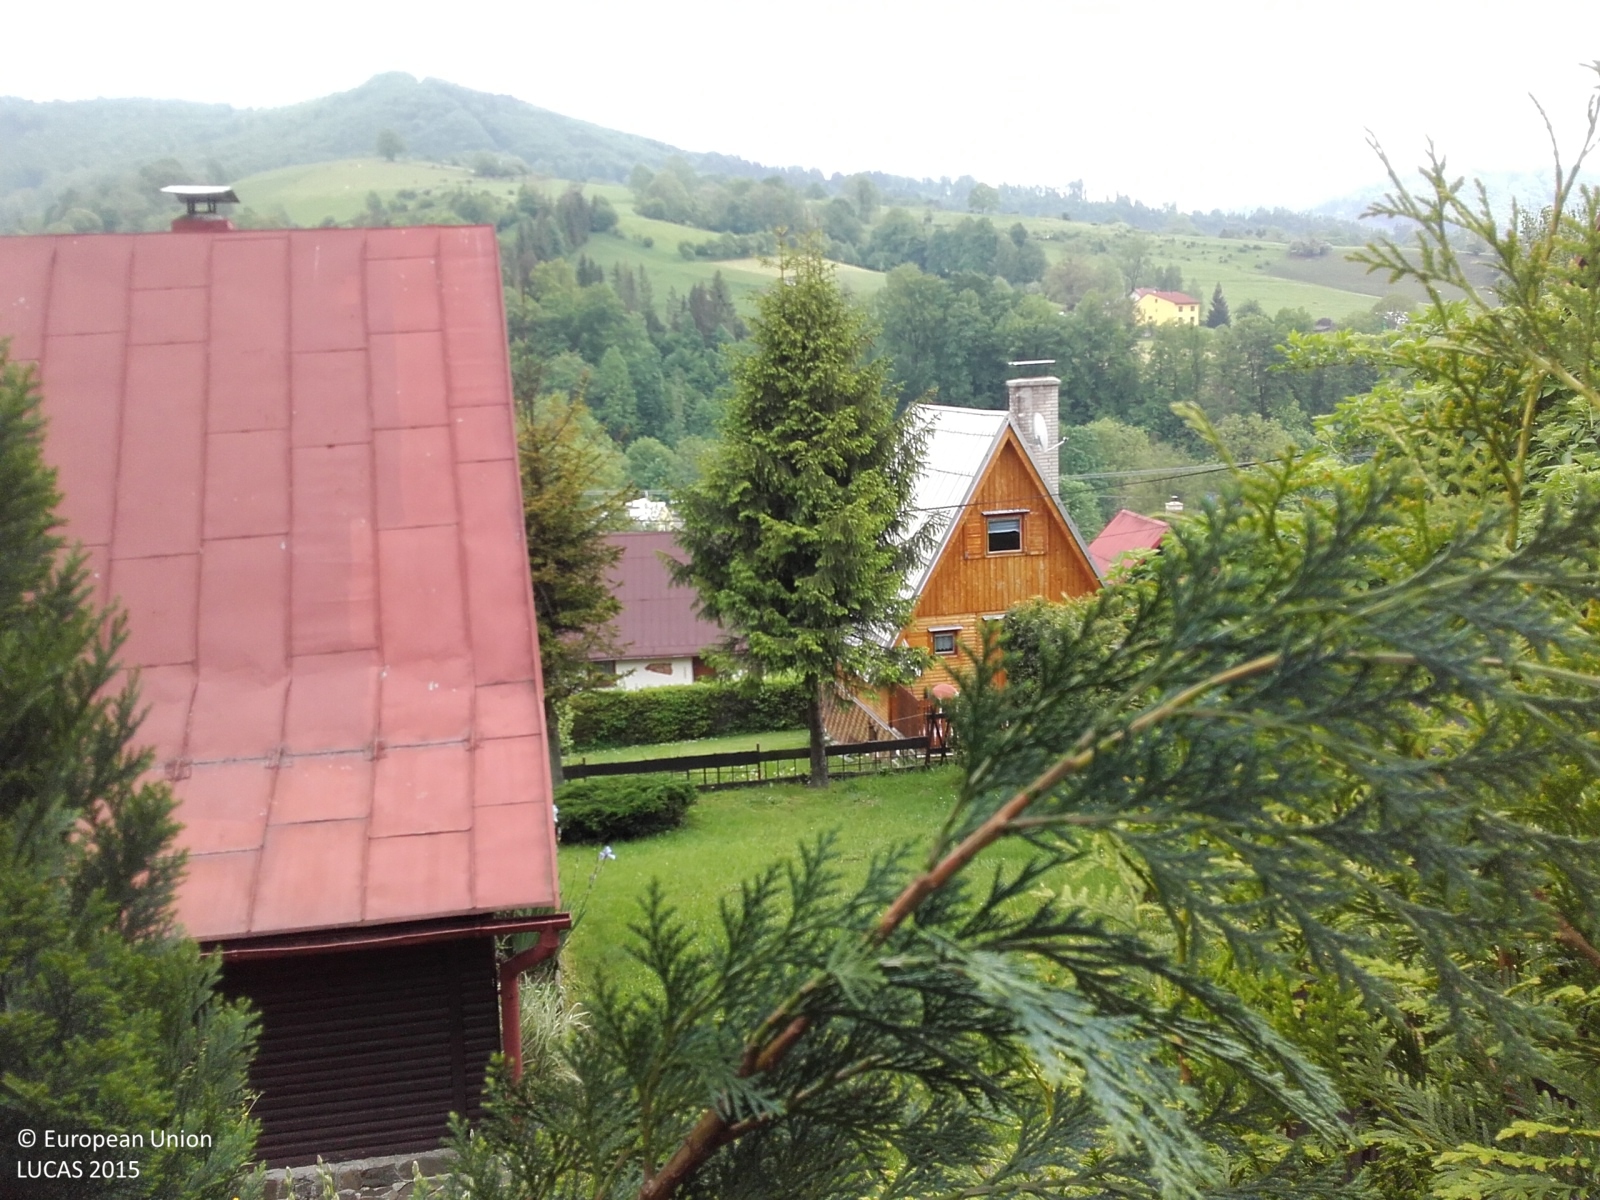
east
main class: Grassland
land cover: Grassland without tree/shrub cover
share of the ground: > 75 %
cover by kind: herbaceous plants 100 %
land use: Residential
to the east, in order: Grassland without tree/shrub cover; Artificial constructions in urban areas; Grassland without tree/shrub cover; Fences; Broadleaved woodland; Grassland without tree/shrub cover; Artificial constructions in urban areas; Broadleaved woodland; Rivers and streams; Broadleaved woodland; Grassland without tree/shrub cover
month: May
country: CZ
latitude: 49.6654
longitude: 18.7630
